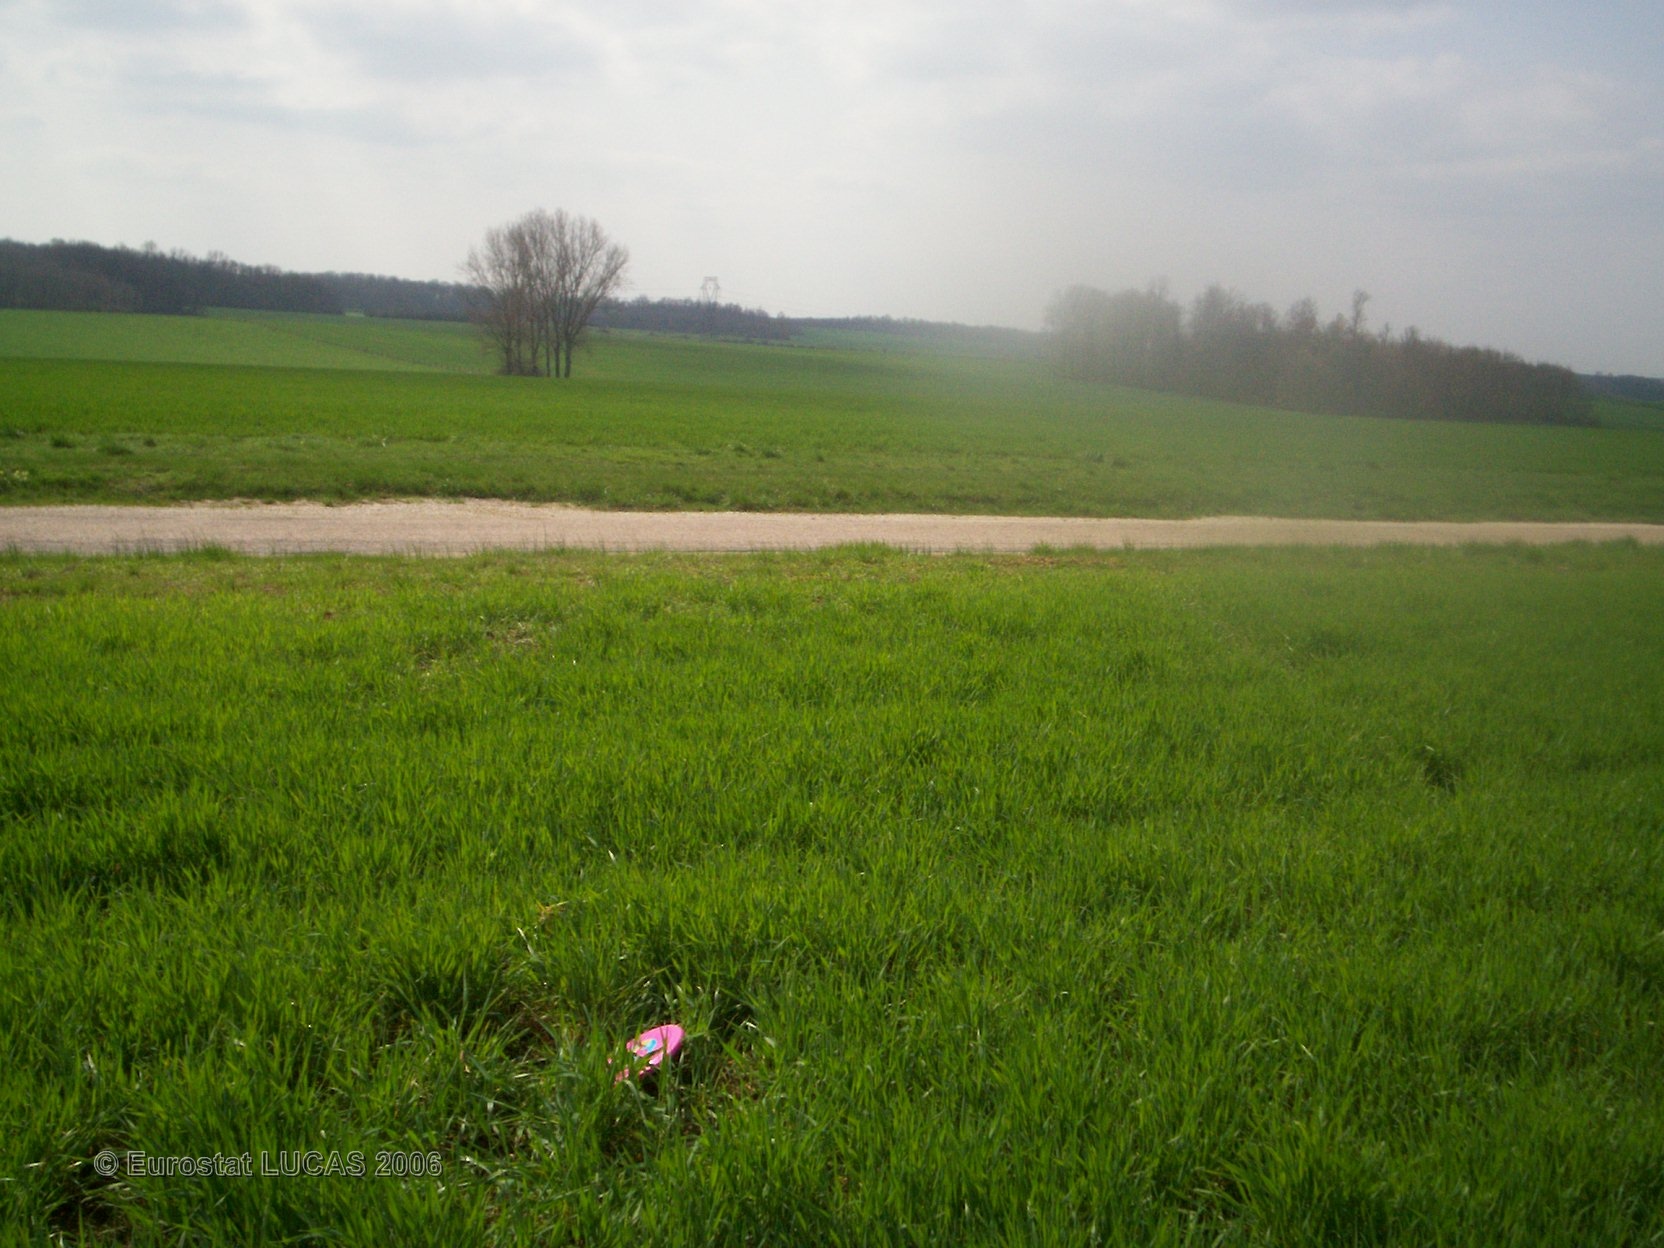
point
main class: Cropland
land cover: Barley
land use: Agriculture (excluding fallow land and kitchen gardens)
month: April
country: FR
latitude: 48.8383
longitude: 5.1616
